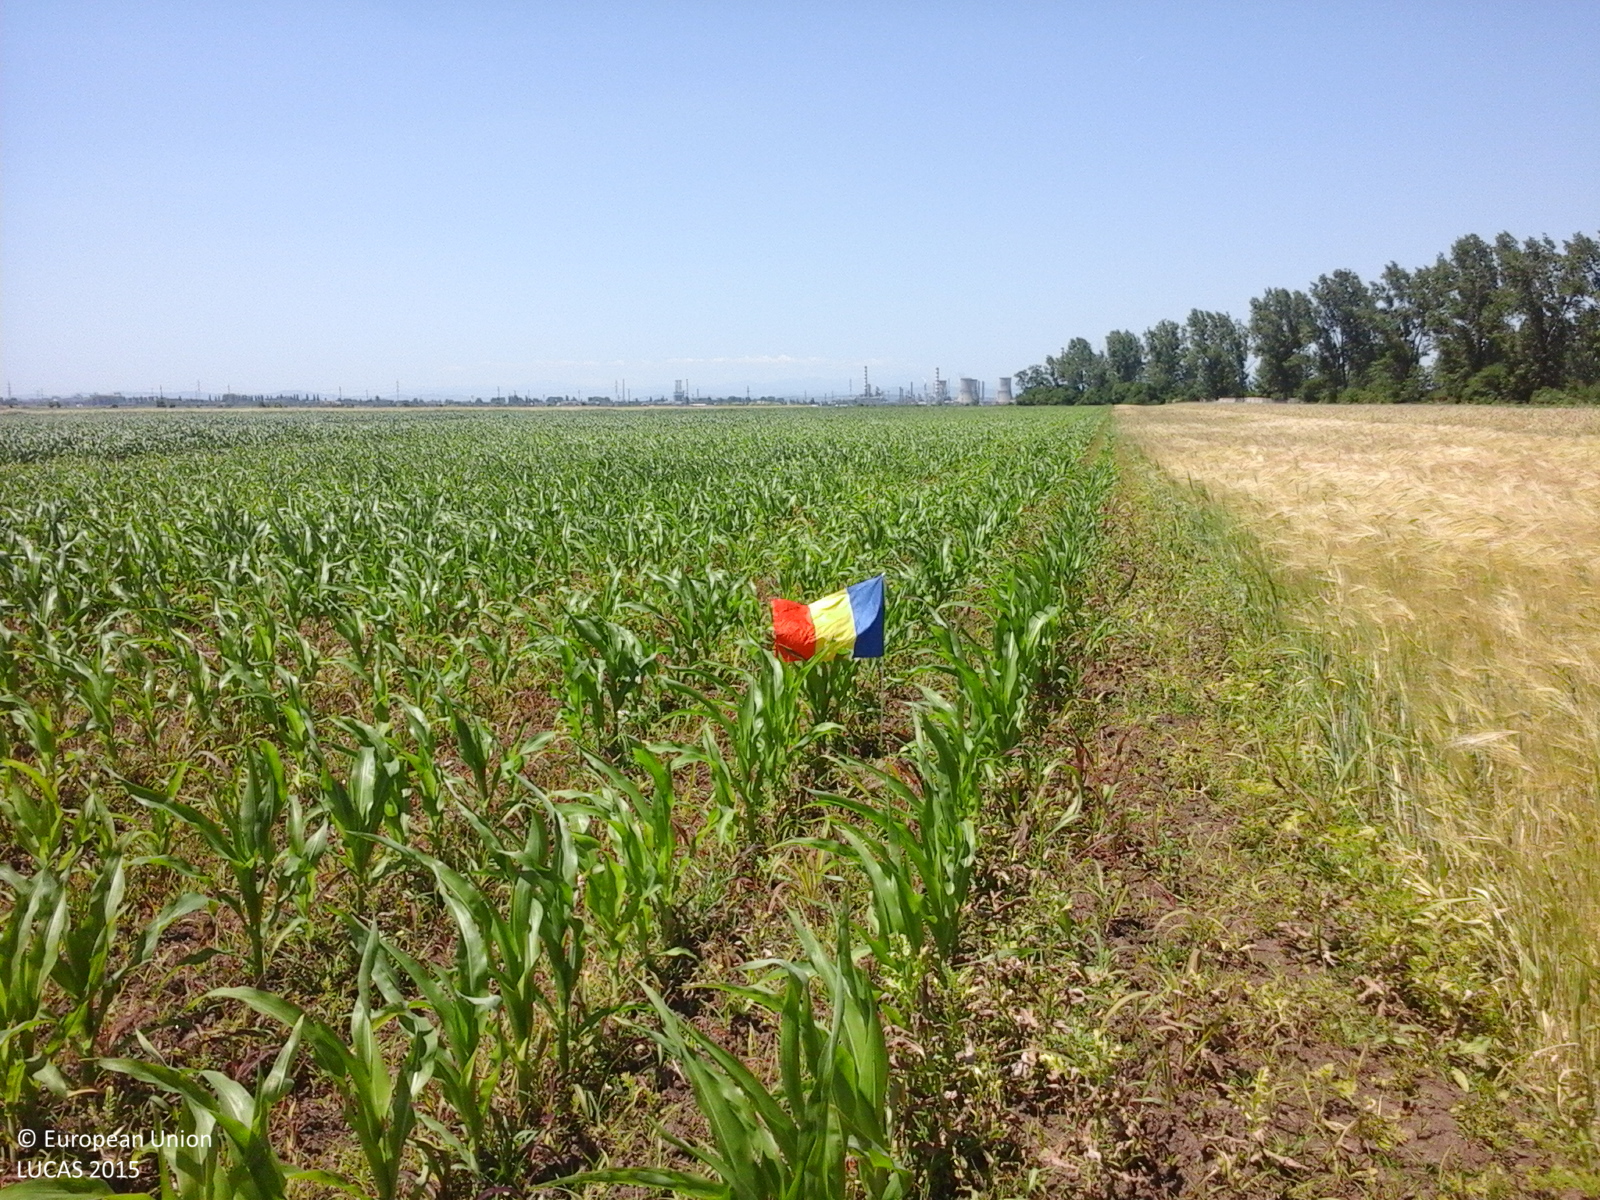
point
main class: Cropland
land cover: Maize
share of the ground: 50 - 75 %
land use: Agriculture (excluding fallow land and kitchen gardens)
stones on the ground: < 10 %
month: June
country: RO
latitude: 44.9180
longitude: 26.1095
